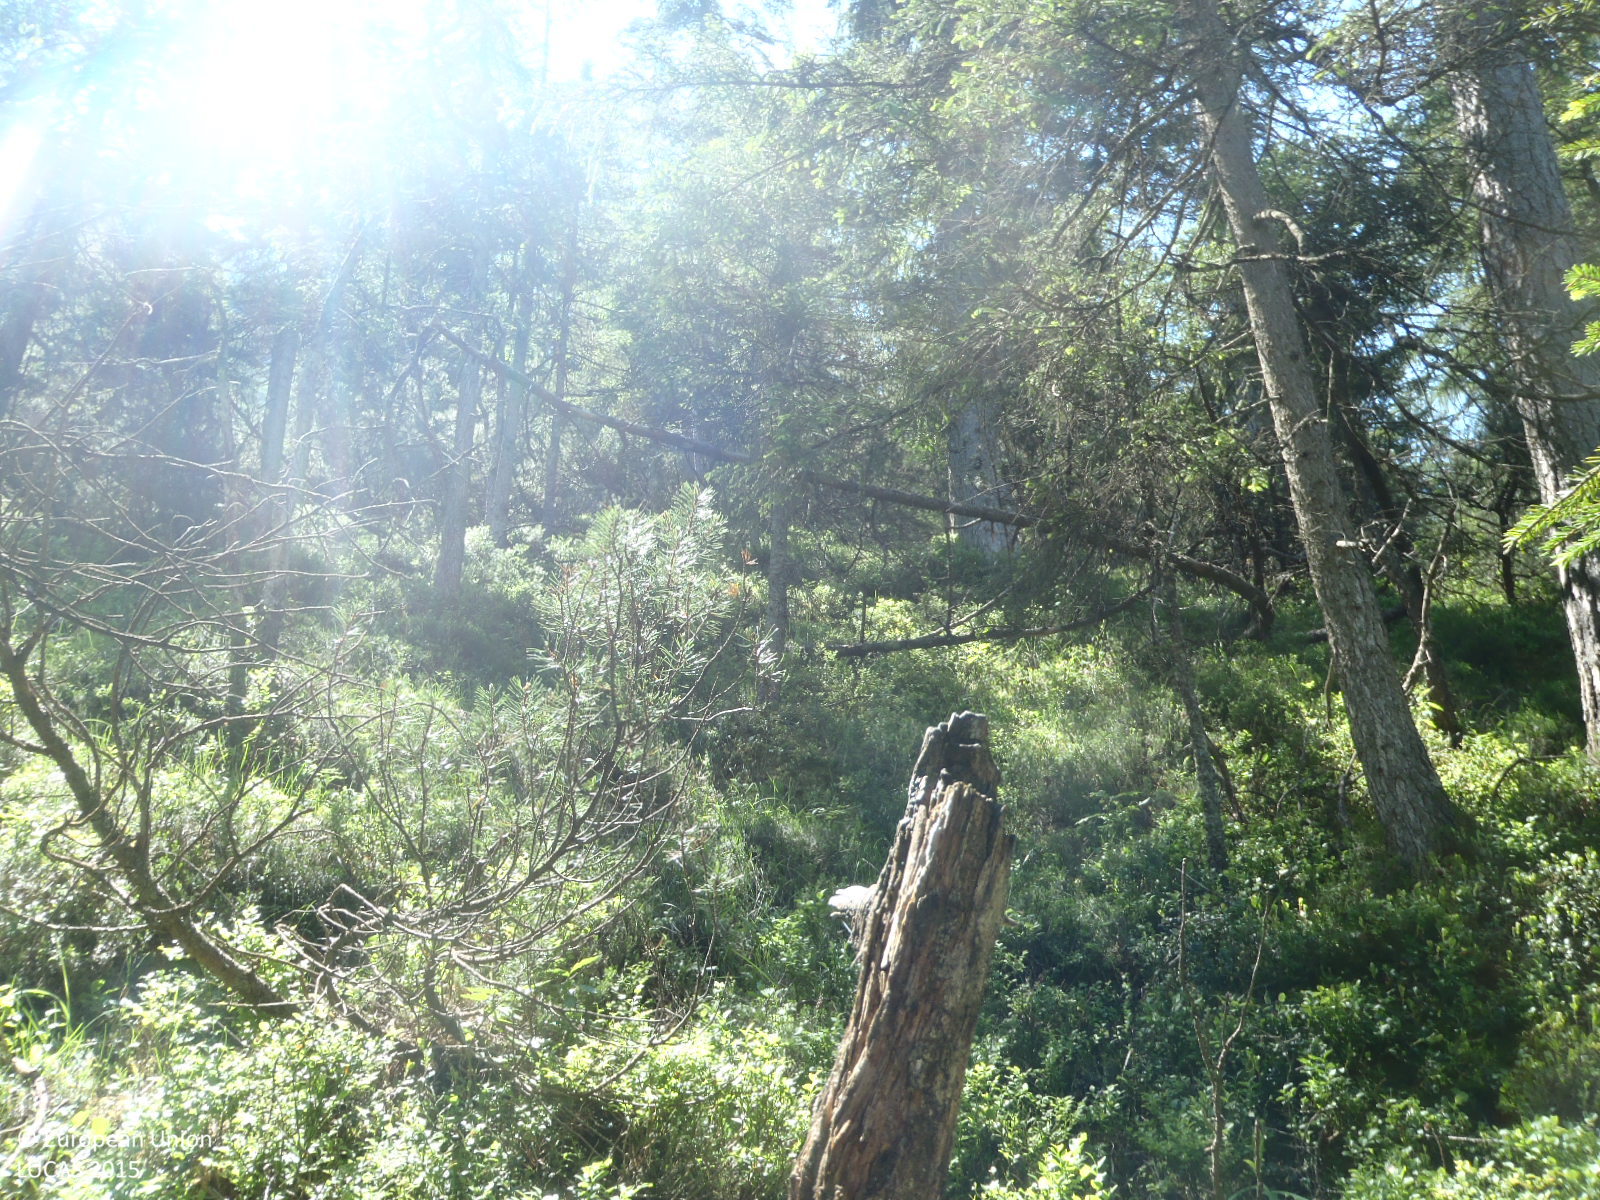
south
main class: Woodland
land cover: Spruce dominated coniferous woodland
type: alpine coniferous forest
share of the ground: > 75 %
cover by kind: coniferous forest trees 100 %
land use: Forestry
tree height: > 5 m
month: June
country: AT
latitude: 47.3562
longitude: 10.8598
